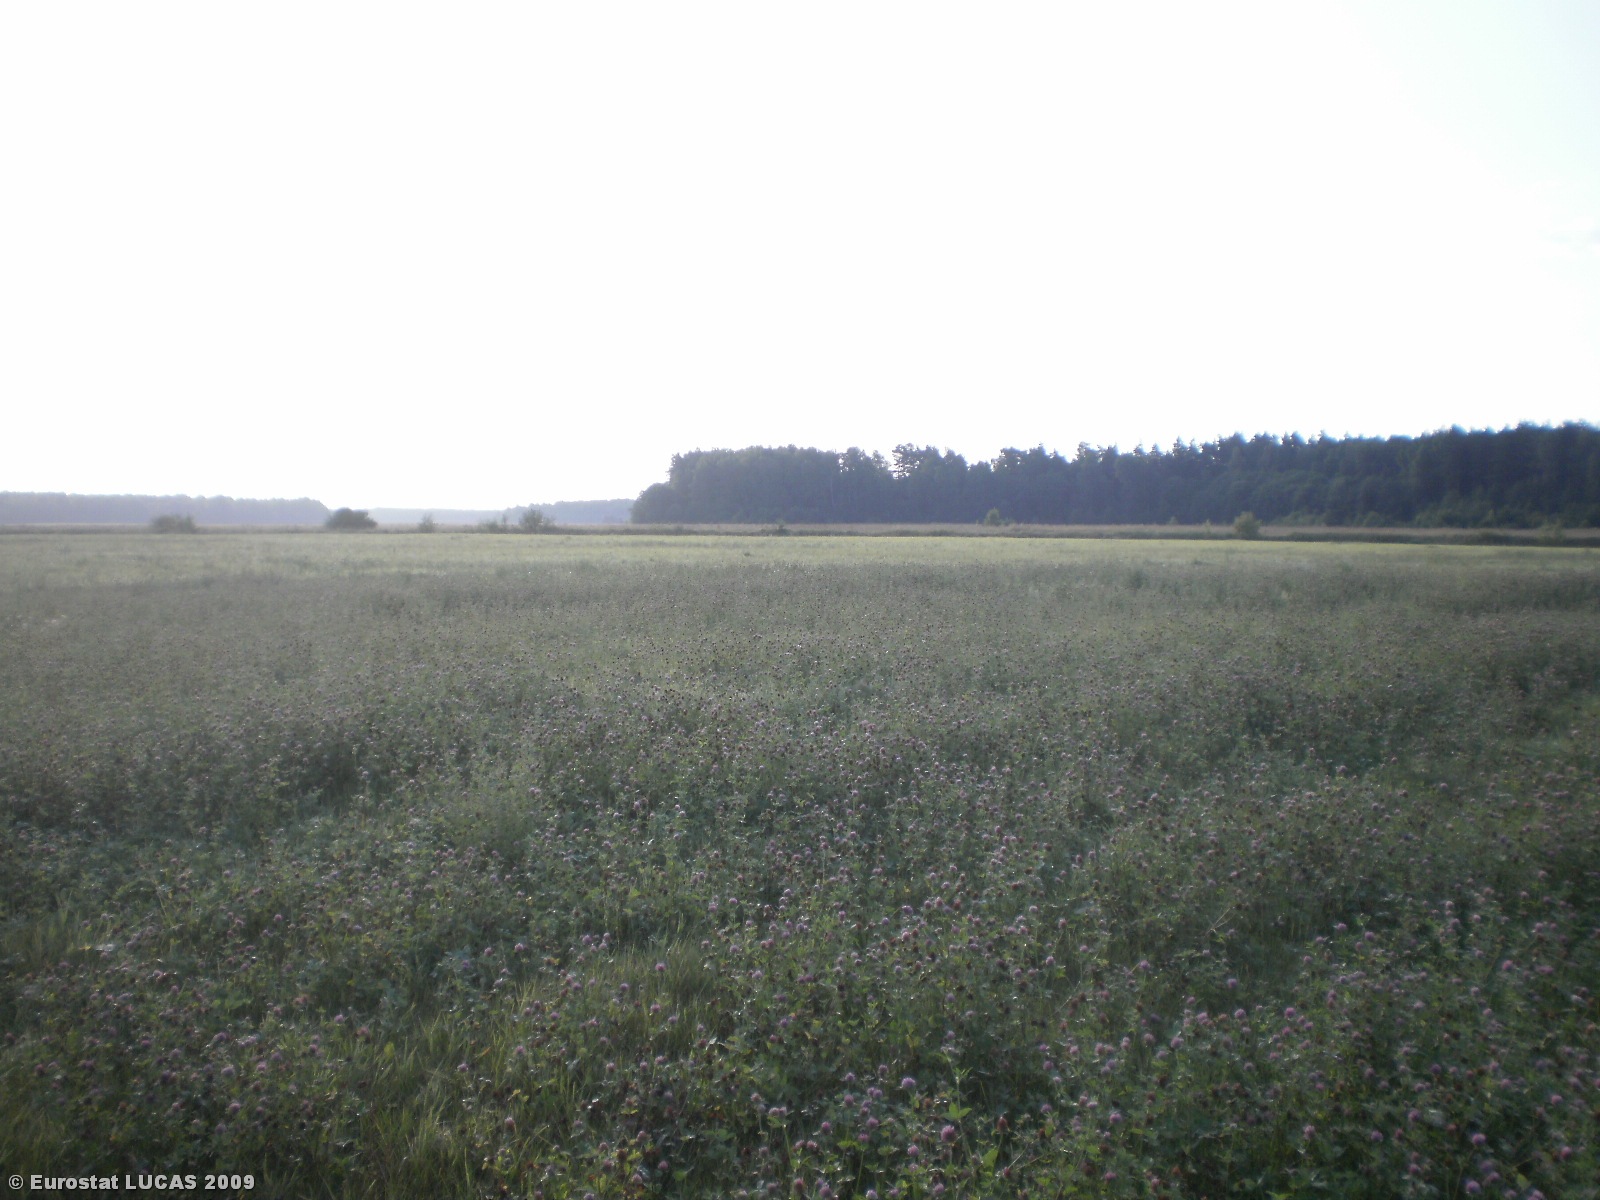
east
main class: Cropland
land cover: Clovers
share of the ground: > 75 %
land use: Agriculture (excluding fallow land and kitchen gardens)
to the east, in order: Clovers; Grassland without tree/shrub cover; Paved roads, cycling and walking lanes; Grassland without tree/shrub cover
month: August
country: LT
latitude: 55.5252
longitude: 24.7912
